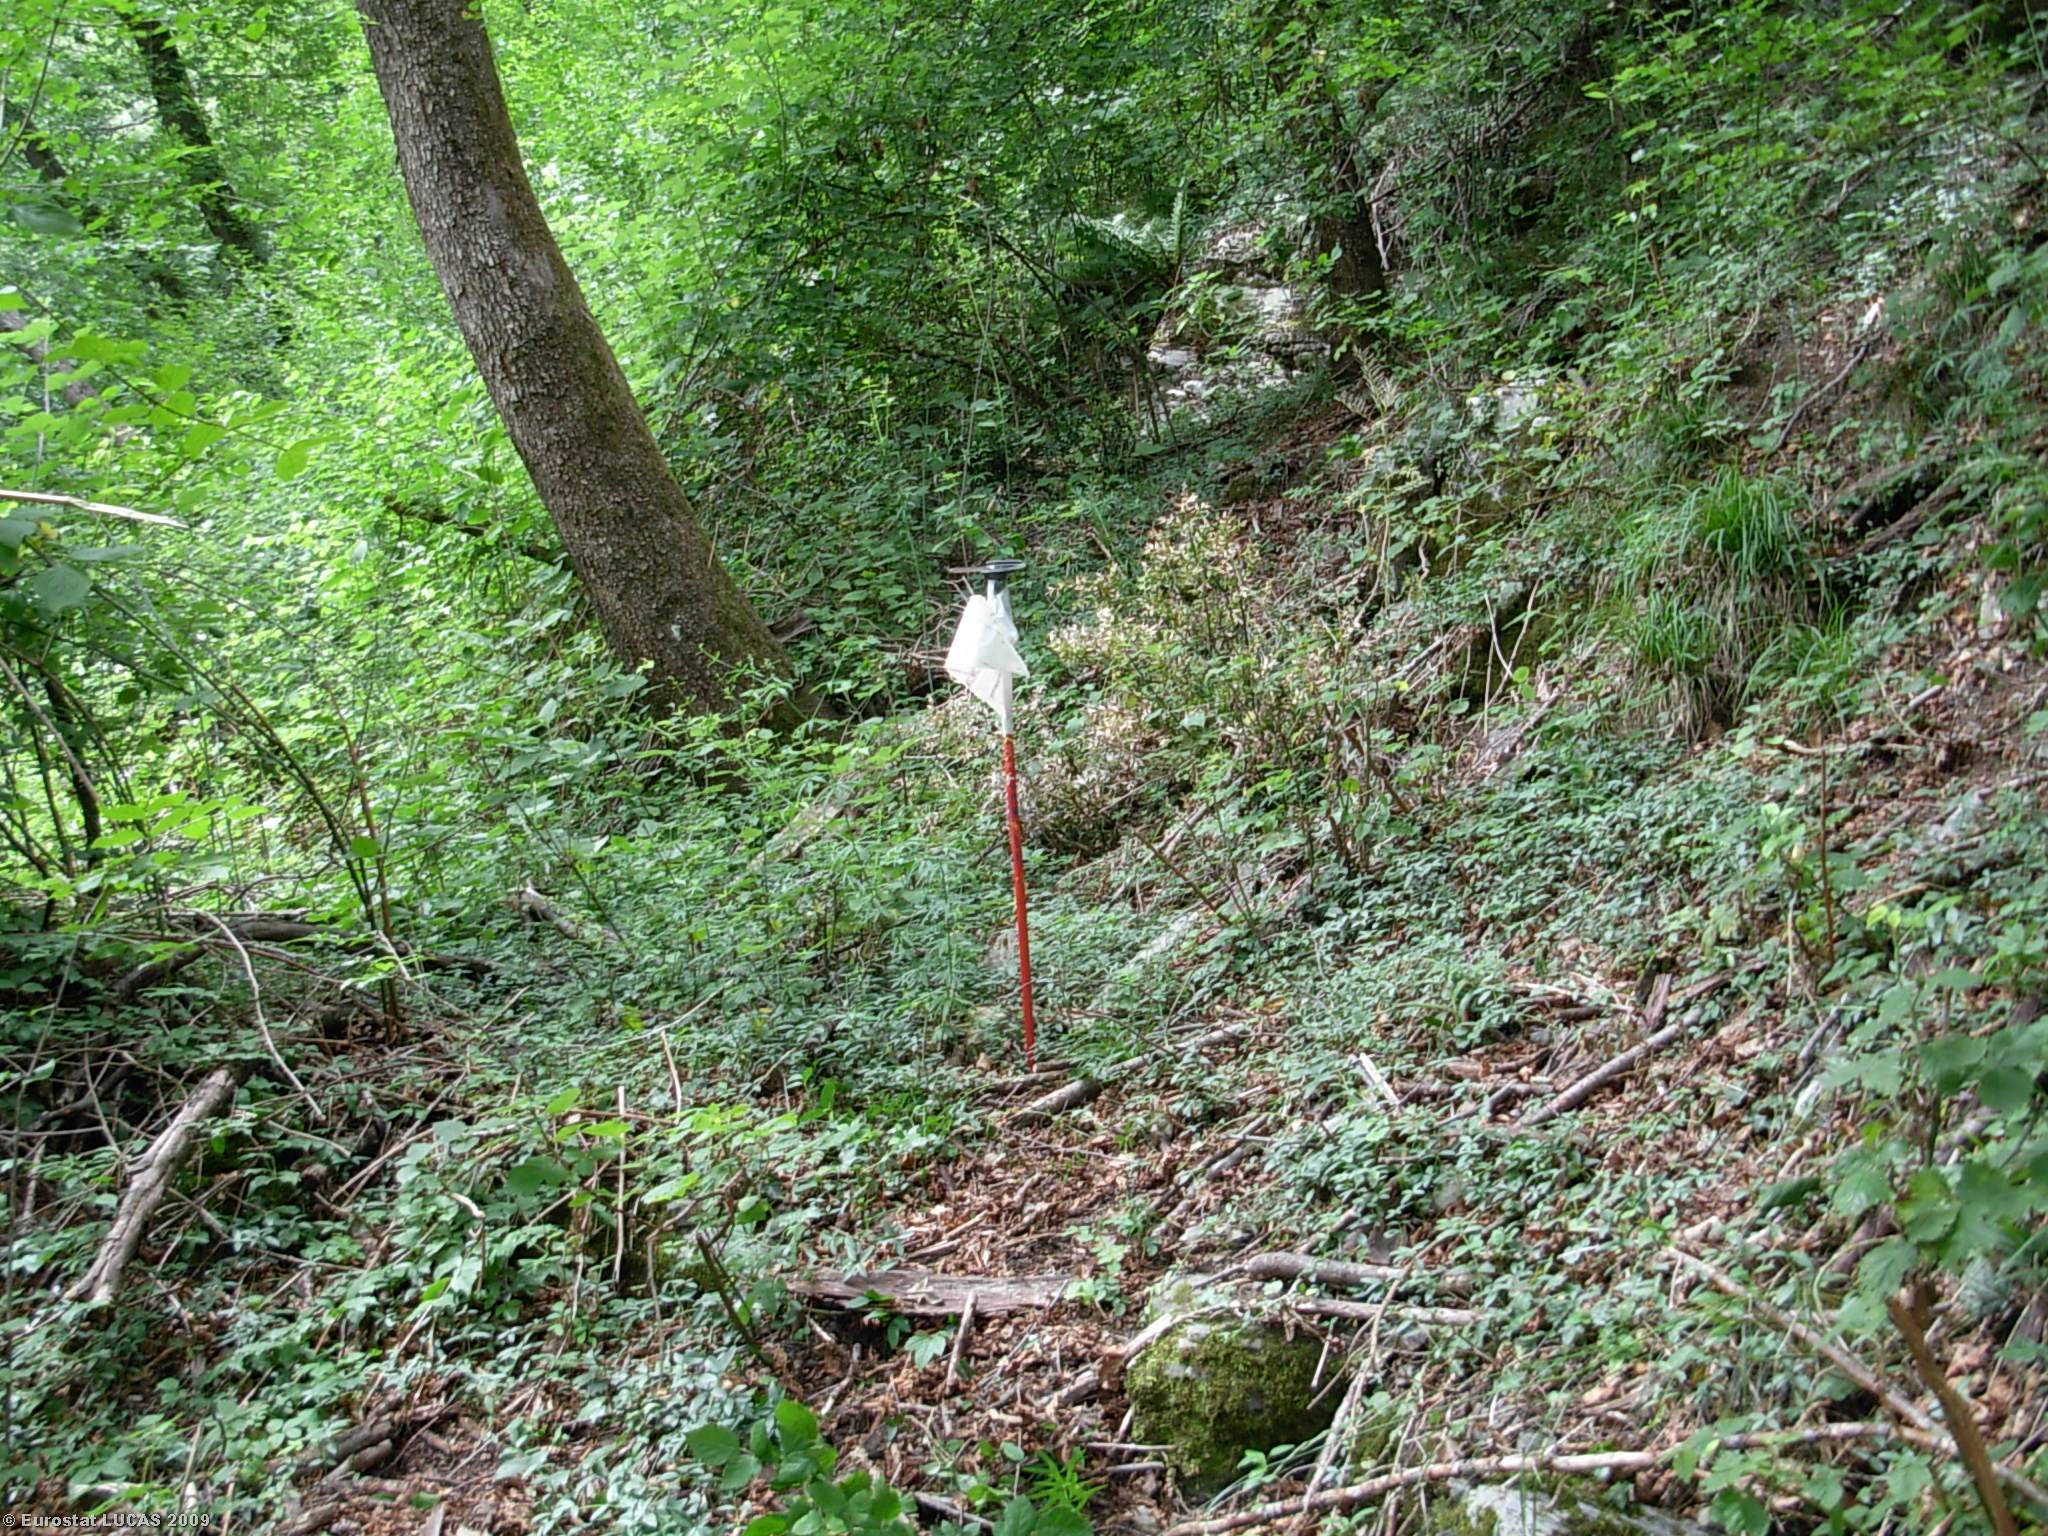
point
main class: Woodland
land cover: Broadleaved woodland
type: mountainous beech forest
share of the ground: > 75 %
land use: Forestry
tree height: > 5 m
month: June
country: IT
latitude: 45.8805
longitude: 9.2924
